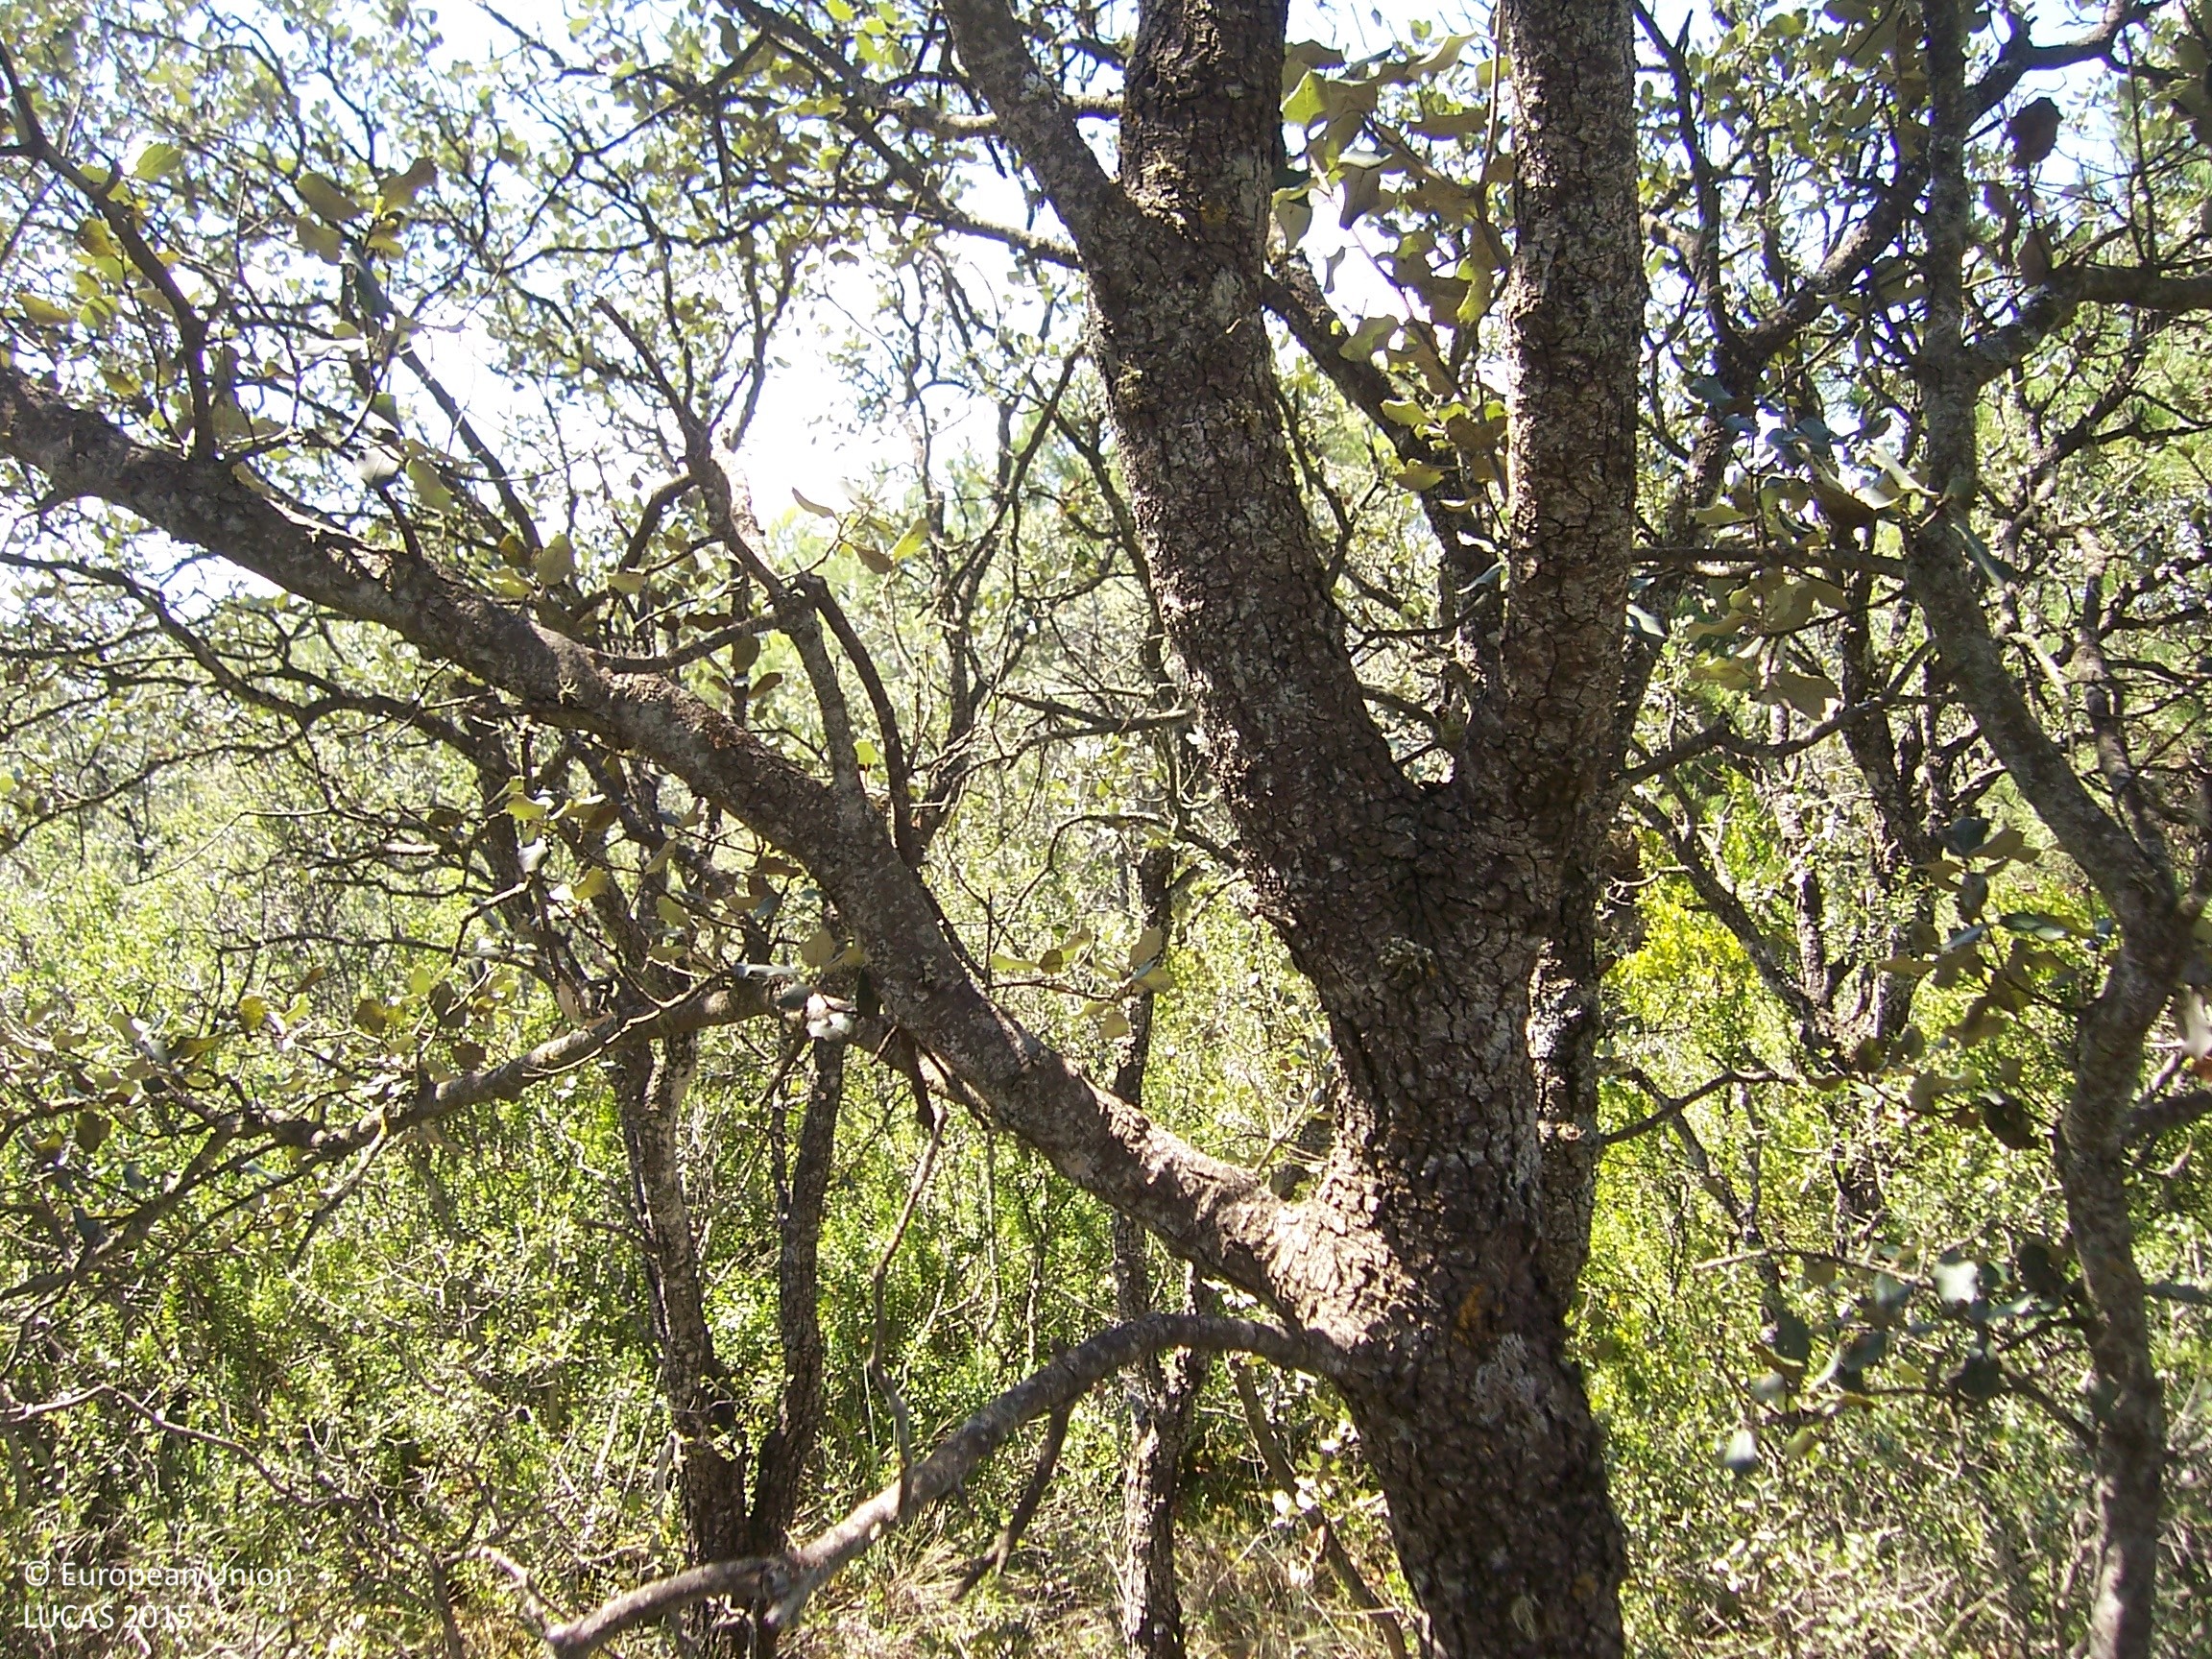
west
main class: Woodland
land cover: Pine dominated mixed woodland
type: coniferous forest of the mediterranean region
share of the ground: > 75 %
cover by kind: coniferous forest trees 40 %, broadleaved forest trees 30 %, shrubs 20 %, herbaceous plants 10 %
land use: Semi-natural and natural areas not in use
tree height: > 5 m
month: August
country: ES
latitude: 41.9580
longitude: 0.5621
